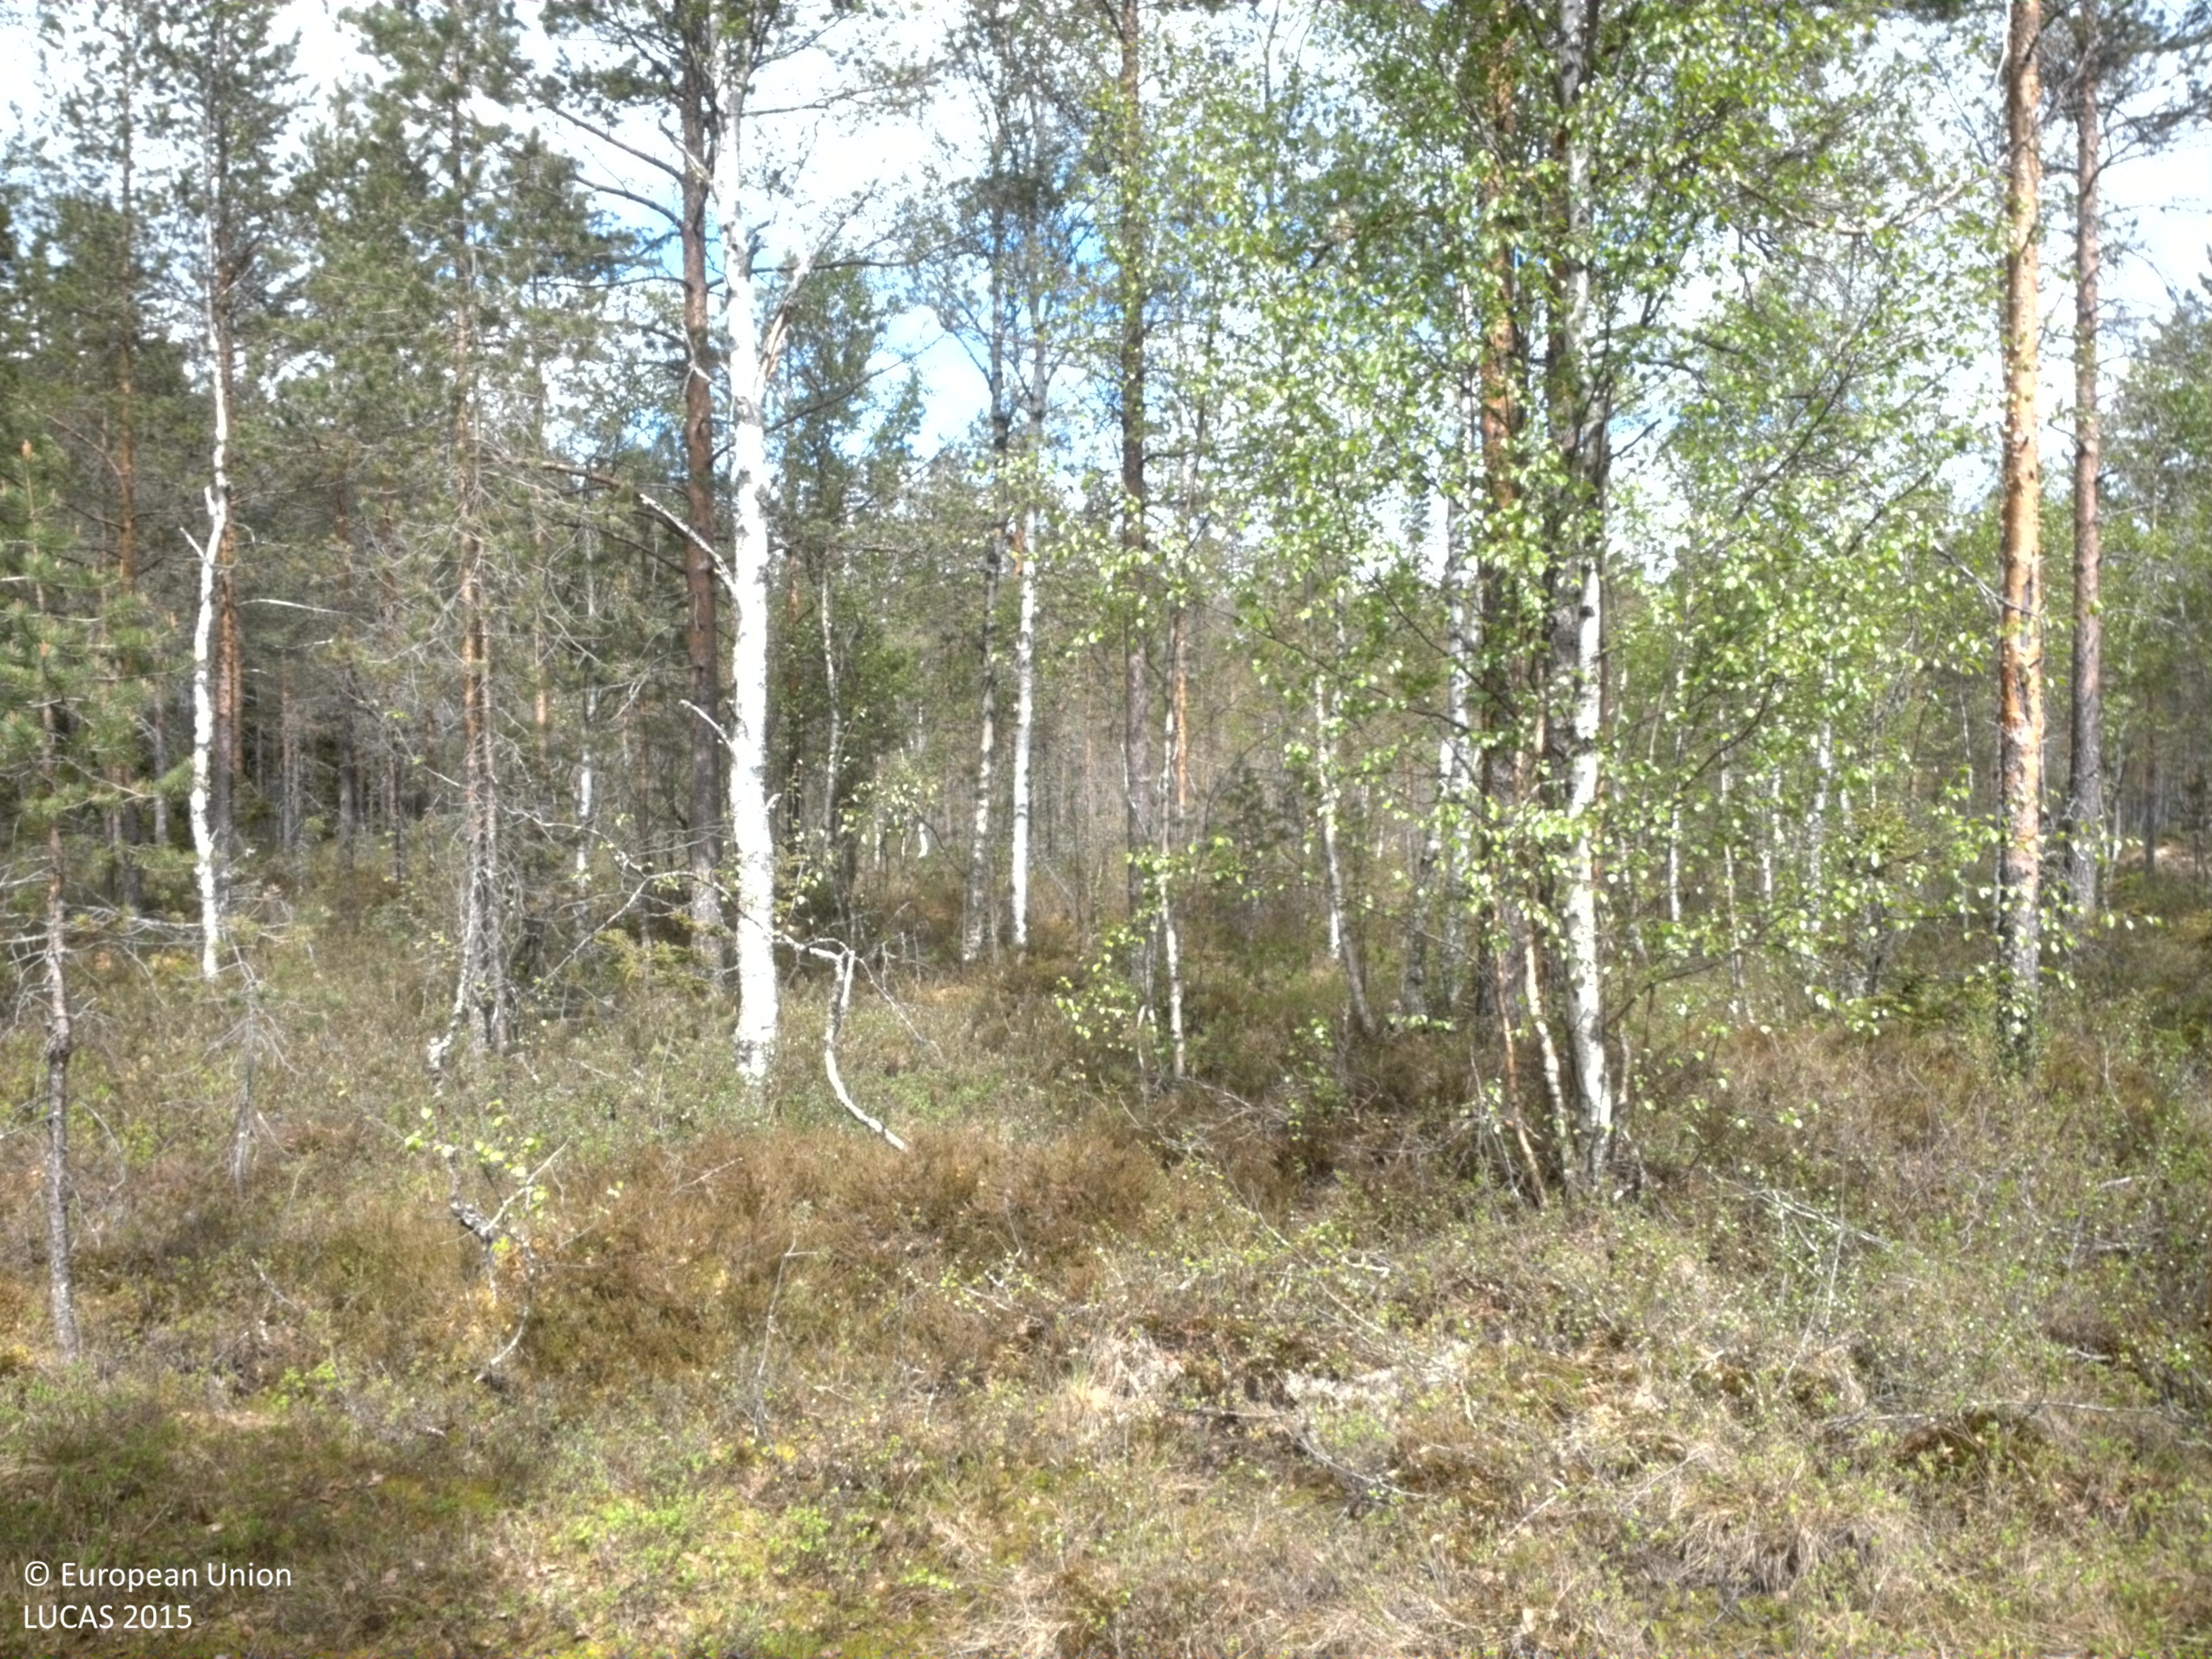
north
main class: Woodland
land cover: Pine dominated mixed woodland
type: mire and swamp forests
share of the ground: 25 - 50 %
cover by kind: shrubs 40 %, coniferous forest trees 30 %, herbaceous plants 15 %, broadleaved forest trees 10 %, lichens and mosses 5 %
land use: Semi-natural and natural areas not in use
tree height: > 5 m
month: June
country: SE
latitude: 63.9555
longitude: 20.5363
